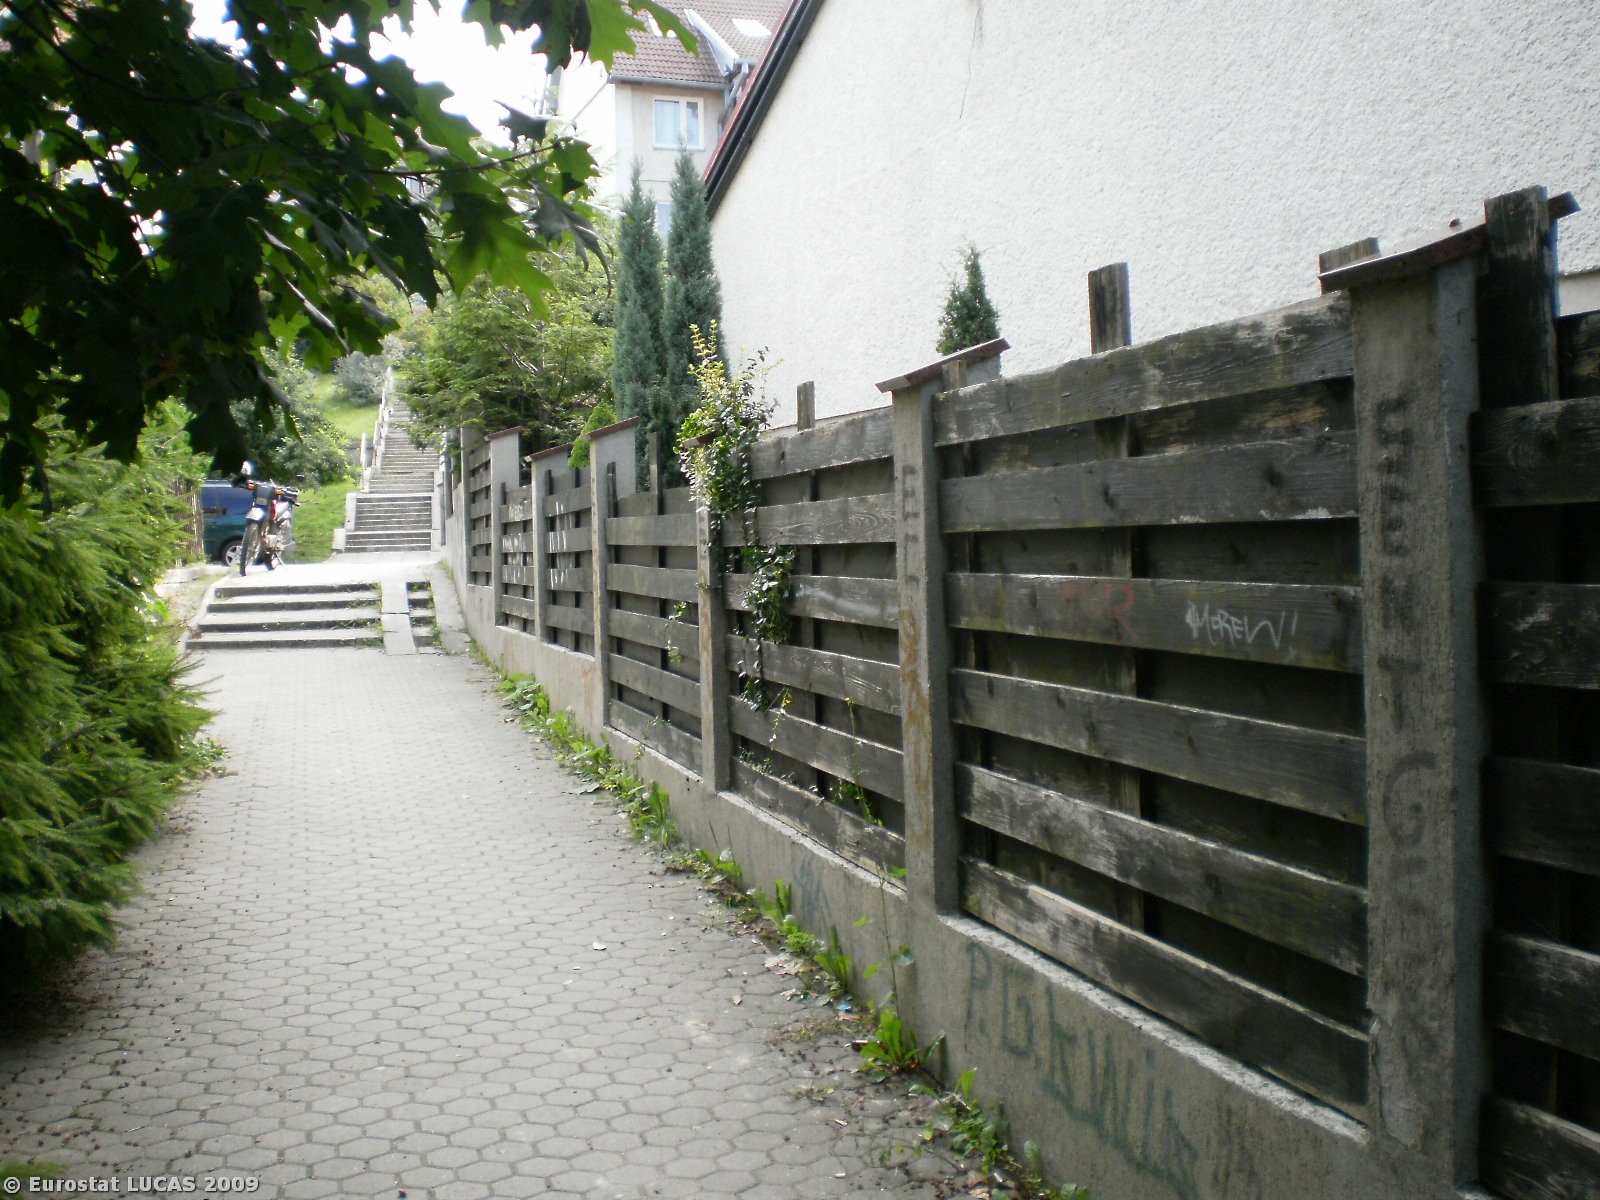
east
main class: Artificial land
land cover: Non built-up linear features
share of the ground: 25 - 50 %
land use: Residential
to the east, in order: Non built-up linear features; Coniferous woodland; Fences; Artificial constructions in urban areas
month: July
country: PL
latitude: 53.7435
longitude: 20.4837
